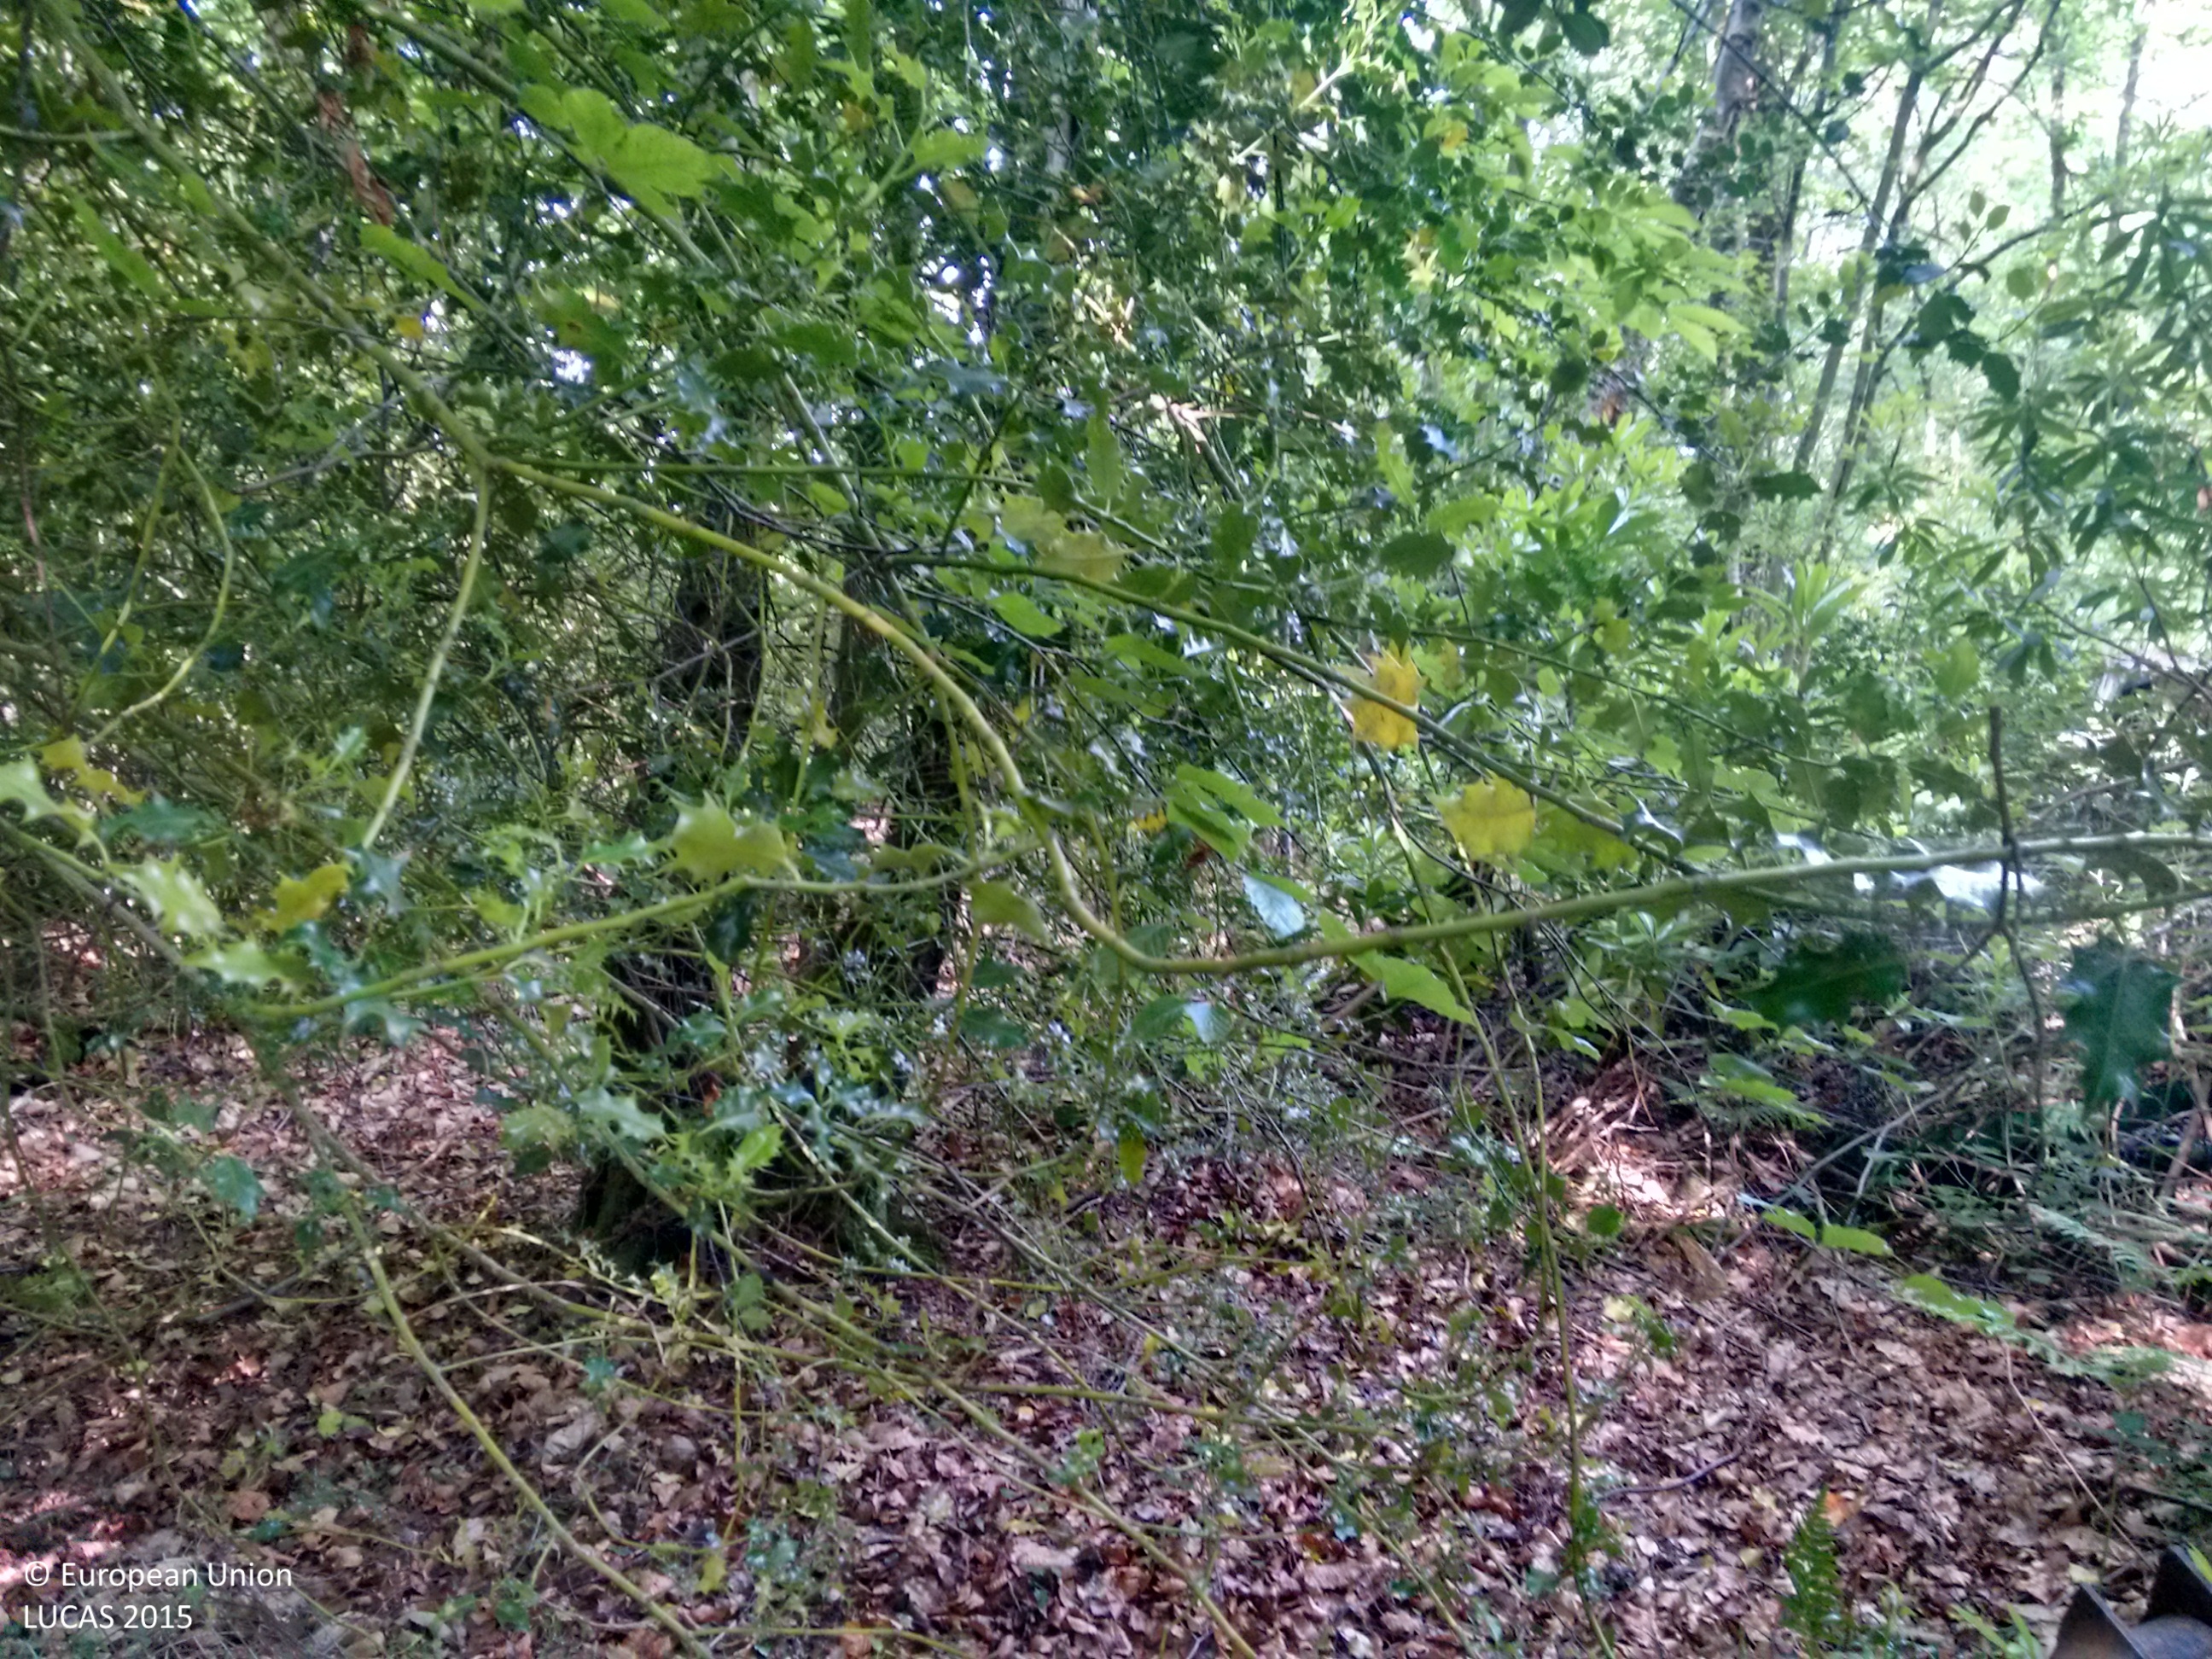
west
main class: Woodland
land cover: Other mixed woodland
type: mesophytic deciduous forest
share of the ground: > 75 %
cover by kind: broadleaved forest trees 75 %, coniferous forest trees 25 %
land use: Semi-natural and natural areas not in use
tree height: > 5 m
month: June
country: GB
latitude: 50.9759
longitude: 0.2134
